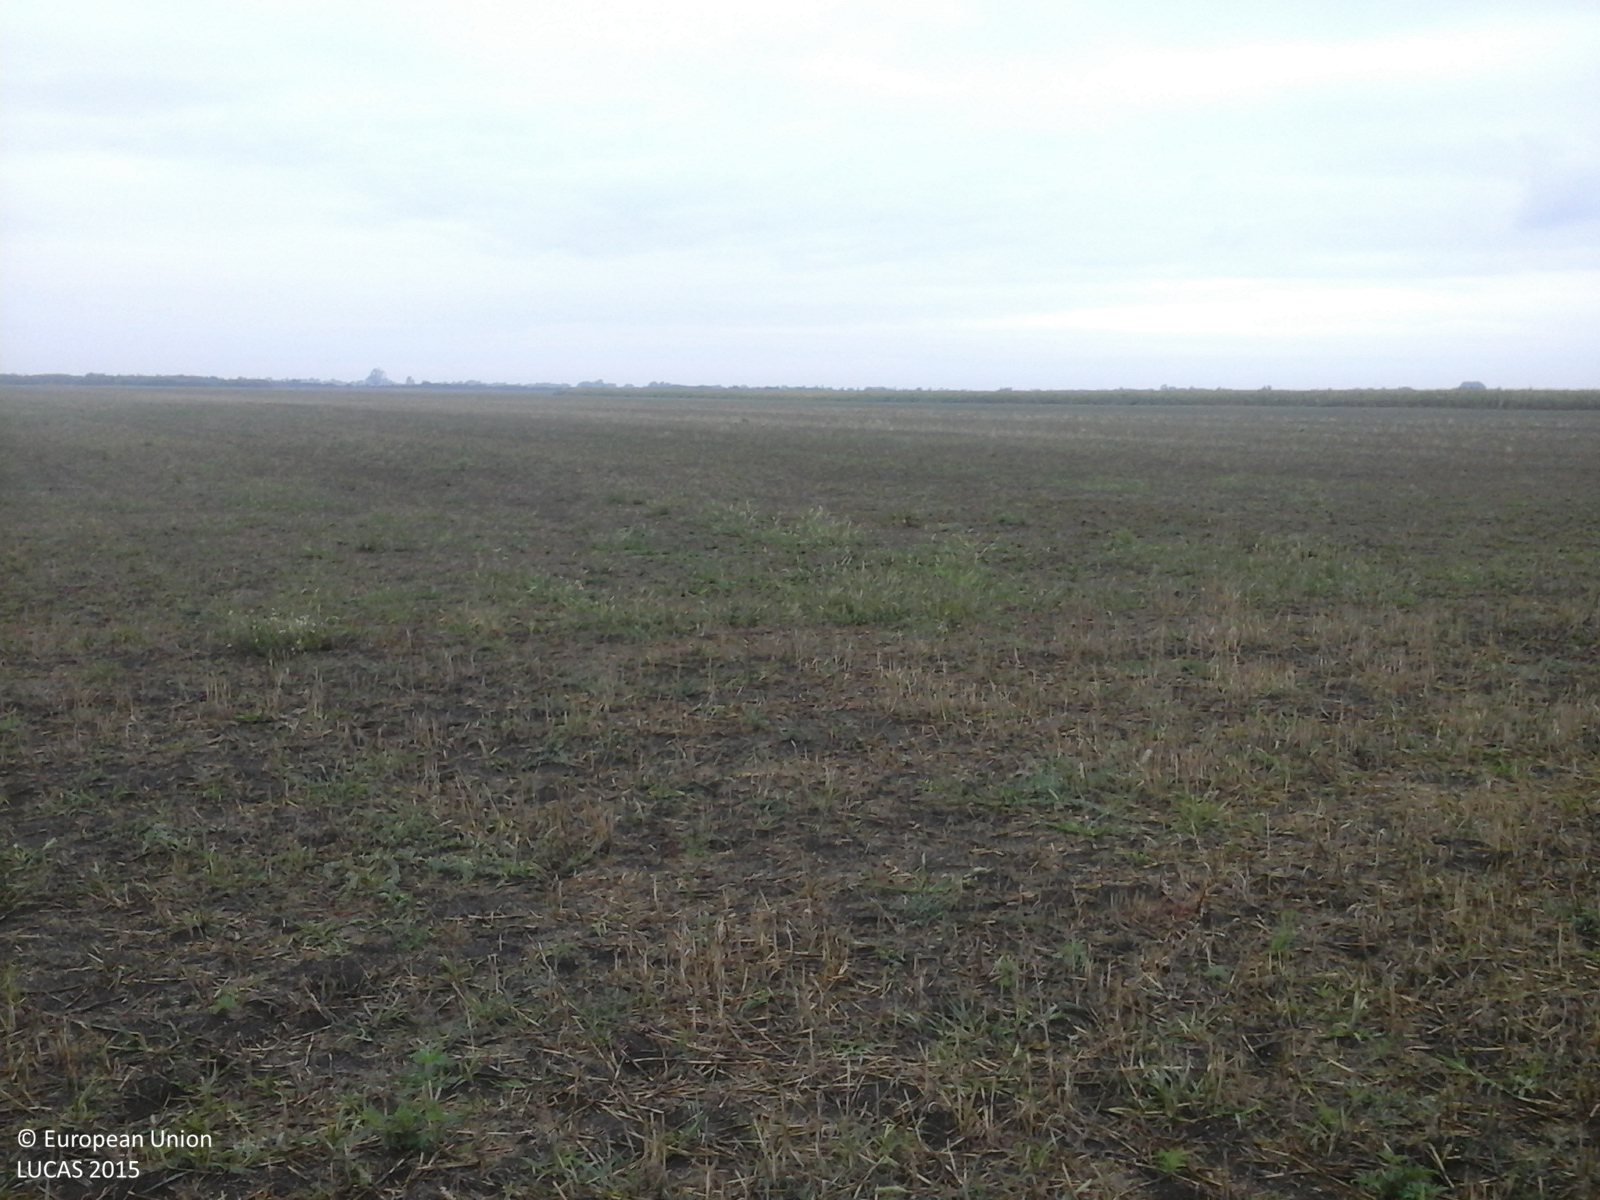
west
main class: Cropland
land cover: Sunflower
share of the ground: > 75 %
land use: Agriculture (excluding fallow land and kitchen gardens)
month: August
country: RO
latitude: 45.6060
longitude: 21.1193
